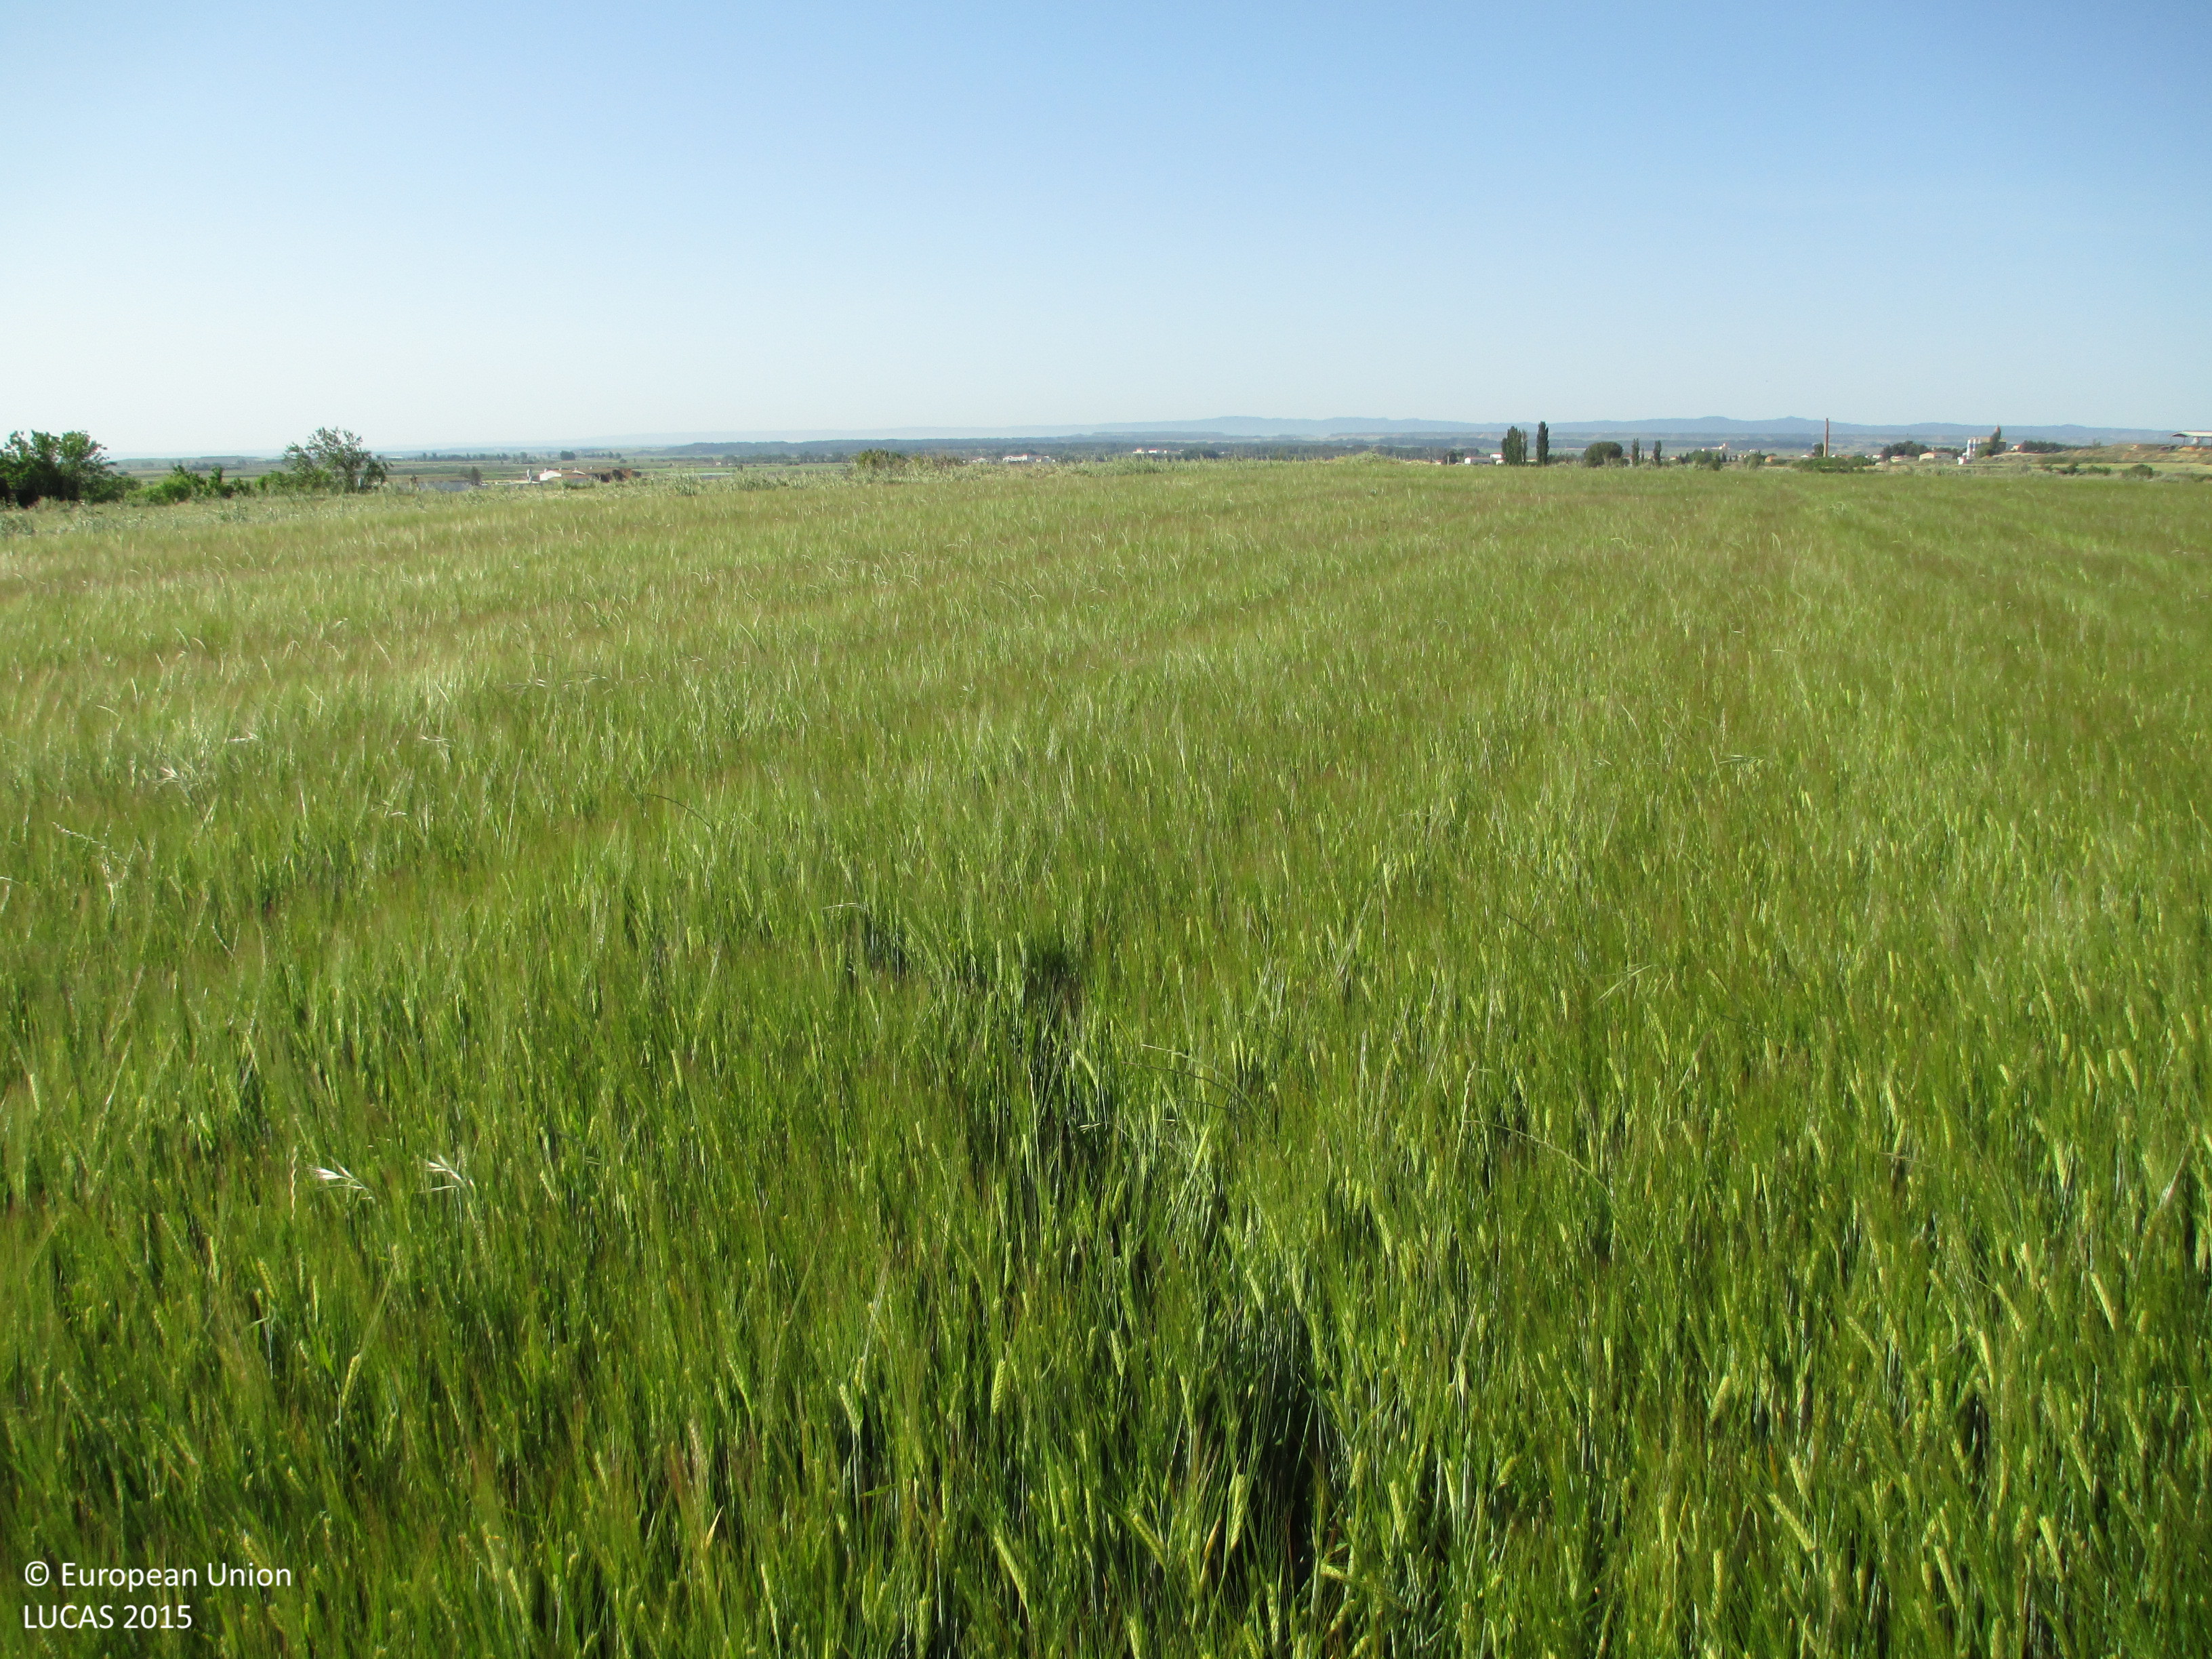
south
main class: Cropland
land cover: Barley
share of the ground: > 75 %
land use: Agriculture (excluding fallow land and kitchen gardens)
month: May
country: ES
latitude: 41.9576
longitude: -0.3602
